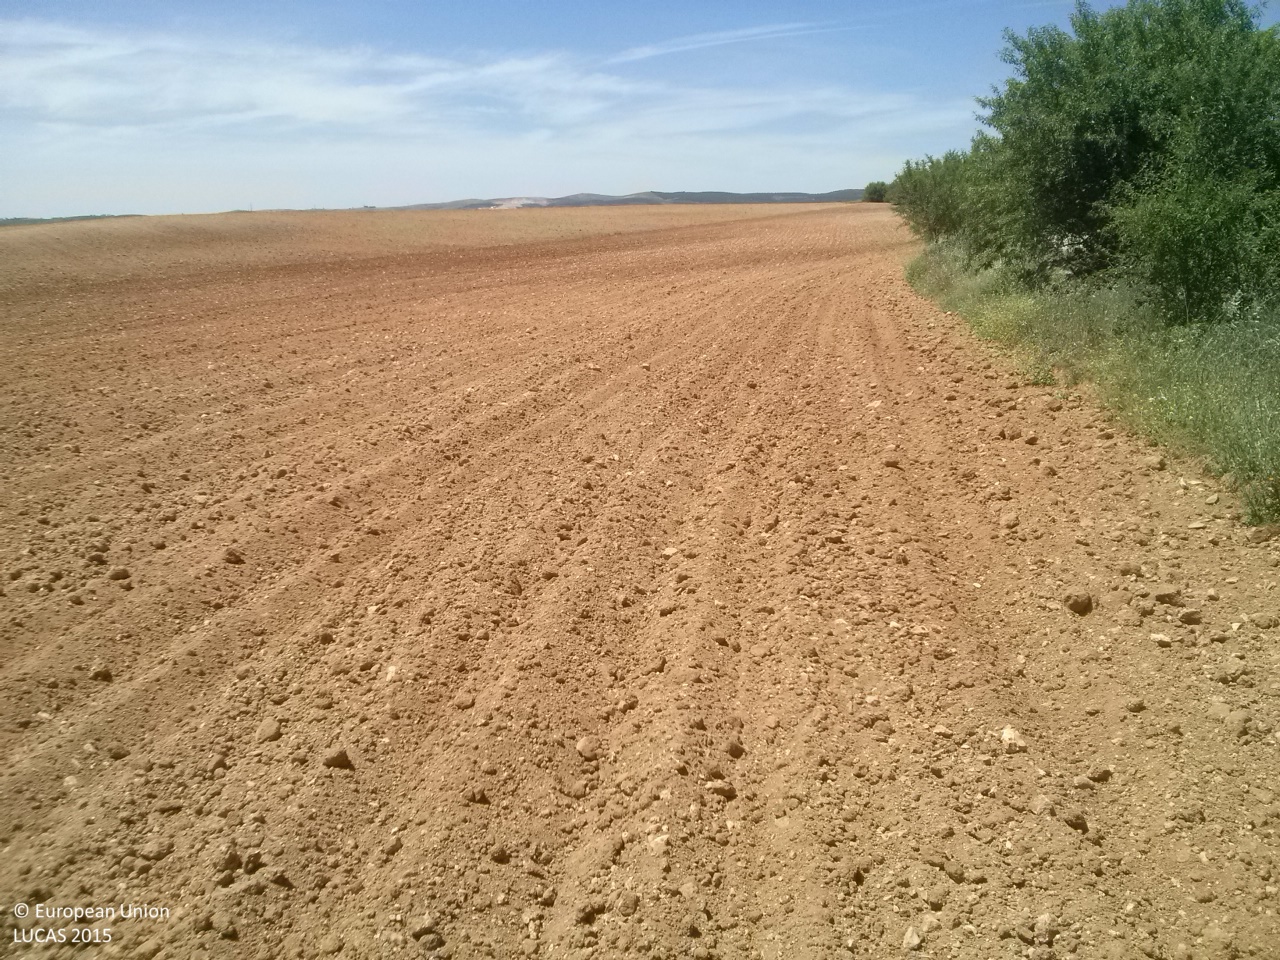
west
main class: Cropland
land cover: Sunflower
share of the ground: < 10 %
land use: Agriculture (excluding fallow land and kitchen gardens)
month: May
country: ES
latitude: 39.9806
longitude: -2.7494
